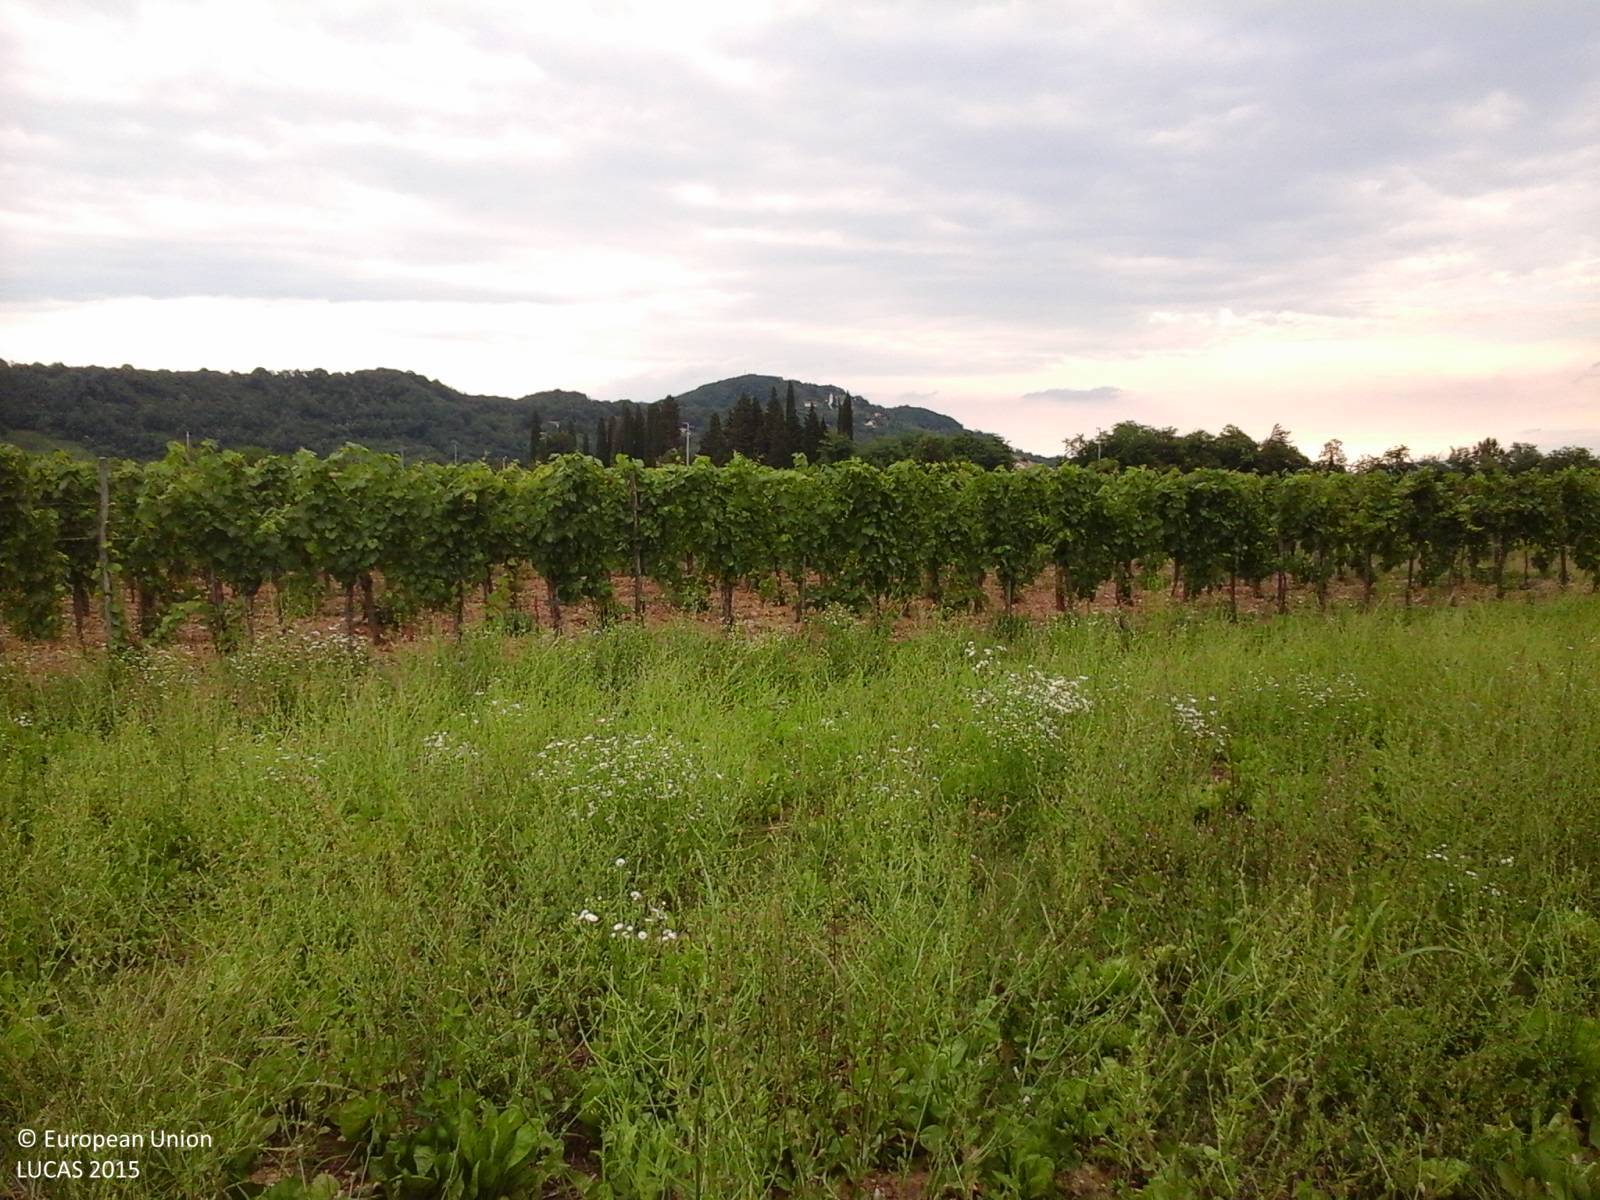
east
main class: Grassland
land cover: Spontaneously vegetated surfaces
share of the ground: > 75 %
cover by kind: herbaceous plants 100 %
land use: Fallow land
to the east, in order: Spontaneously vegetated surfaces; Vineyards; Tracks; Vineyards; Soya; Maize; Vineyards
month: June
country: IT
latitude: 45.9713
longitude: 13.4420
